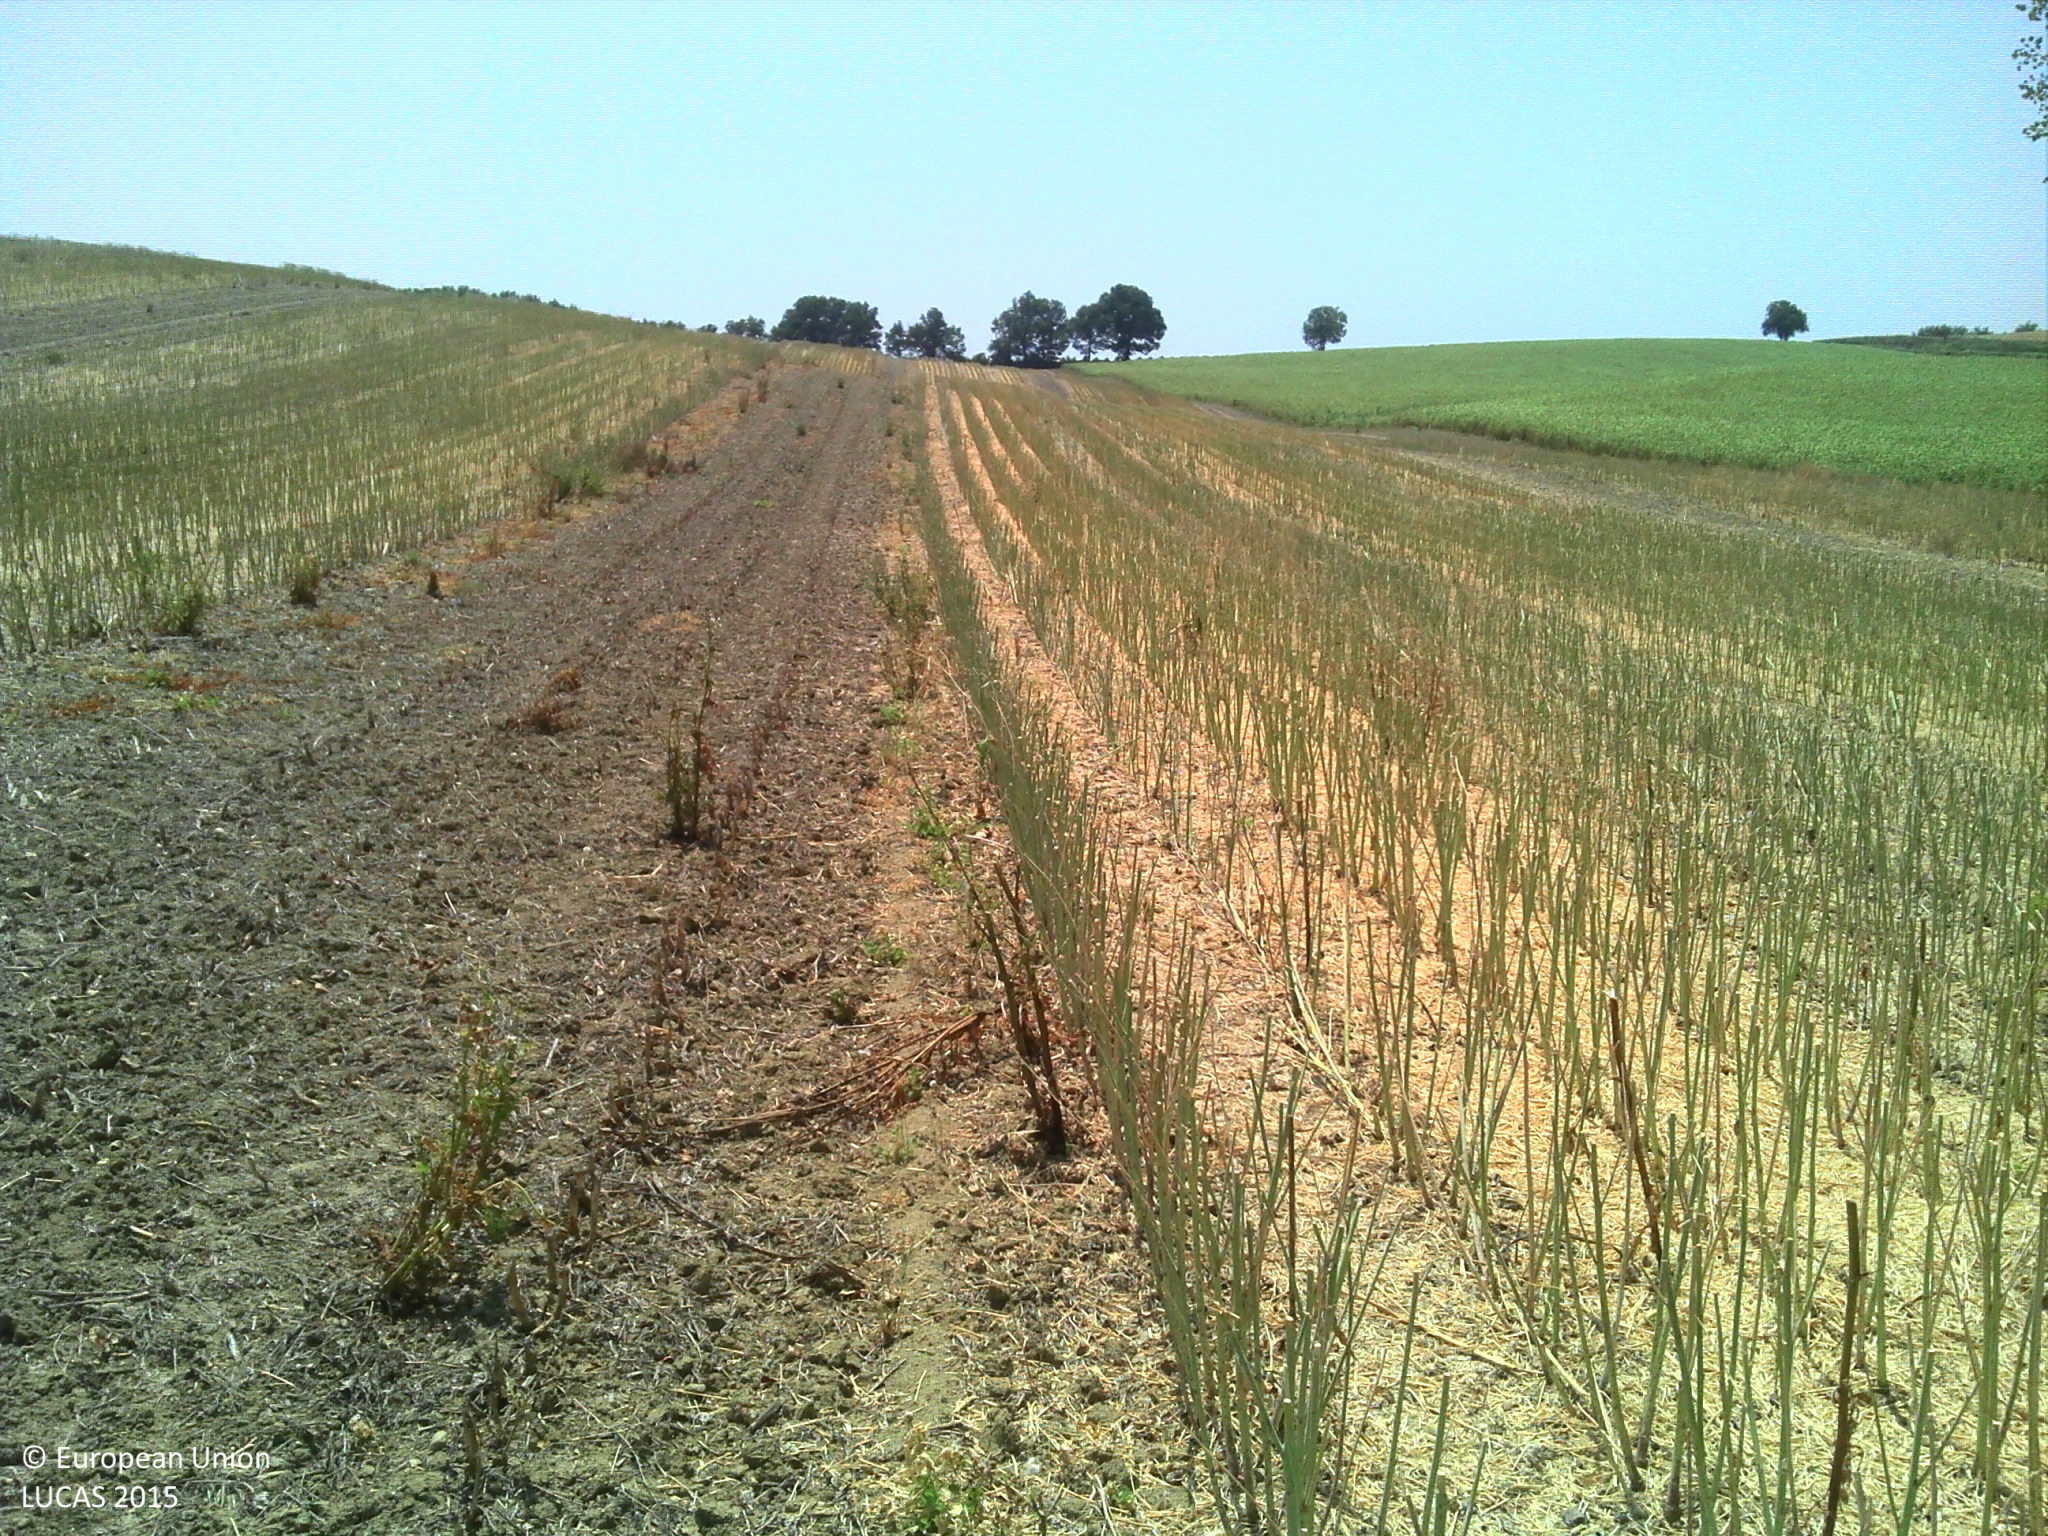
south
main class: Cropland
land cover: Rape and turnip rape
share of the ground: > 75 %
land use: Agriculture (excluding fallow land and kitchen gardens)
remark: Harvested field
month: July
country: FR
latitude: 43.1214
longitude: 2.0554
